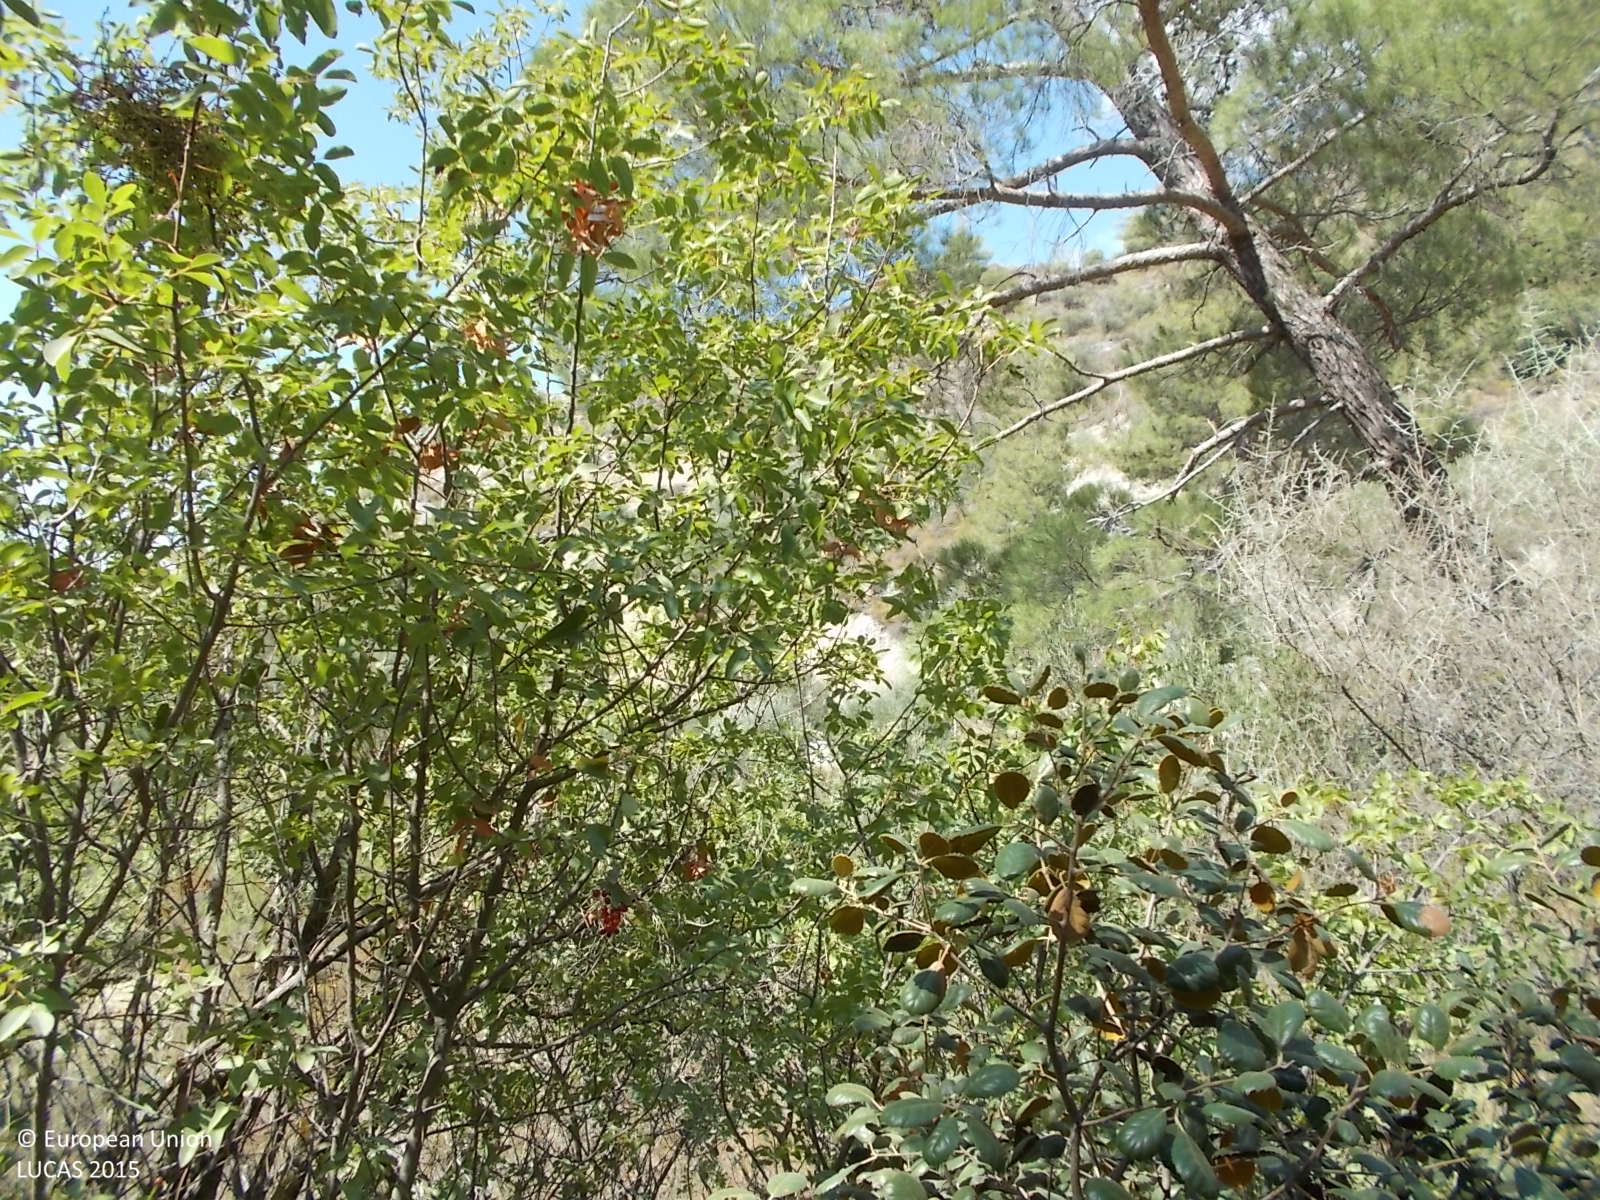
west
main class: Woodland
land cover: Pine dominated mixed woodland
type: coniferous forest of the mediterranean region
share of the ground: 50 - 75 %
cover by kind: coniferous forest trees 45 %, shrubs 25 %, broadleaved forest trees 15 %, unconsolidated bare surface 15 %
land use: Semi-natural and natural areas not in use
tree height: > 5 m
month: September
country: CY
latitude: 34.8648
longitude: 33.0896
